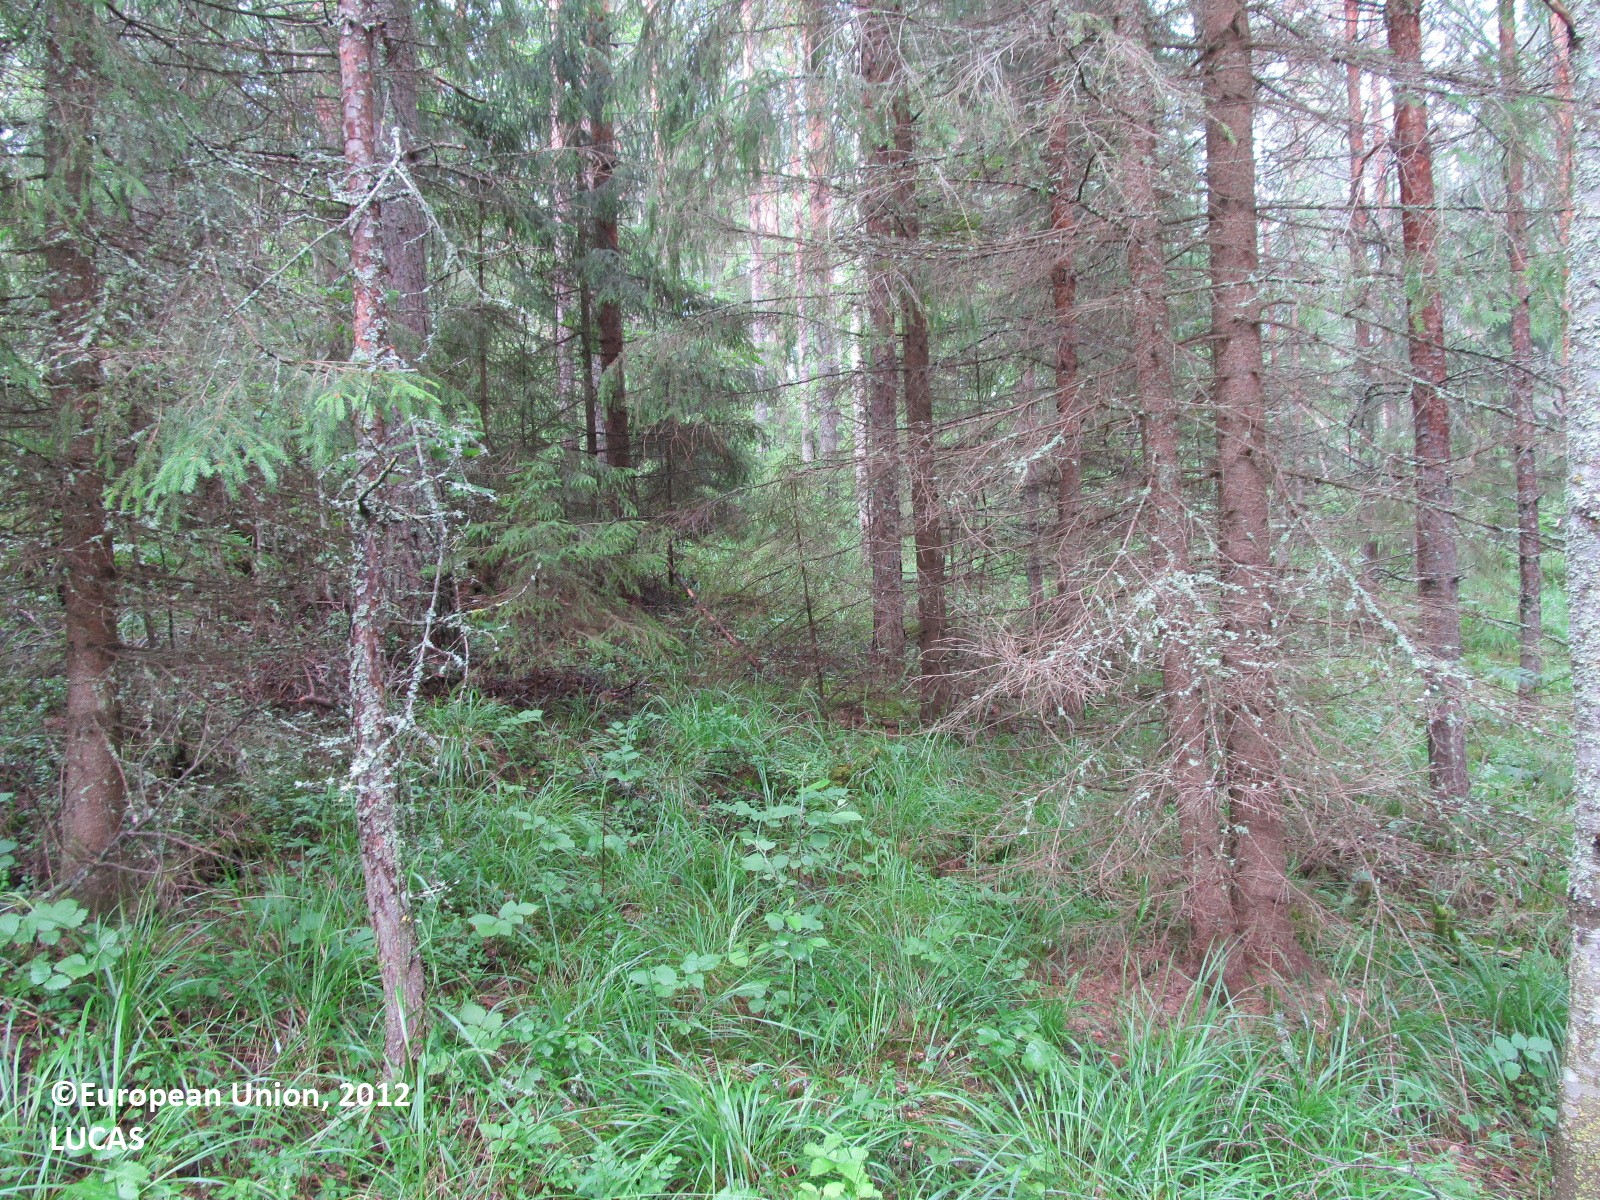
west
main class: Woodland
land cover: Spruce dominated mixed woodland
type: boreal forest
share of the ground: 25 - 50 %
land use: Forestry
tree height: > 5 m
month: July
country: FI
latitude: 61.8618
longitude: 28.4737
